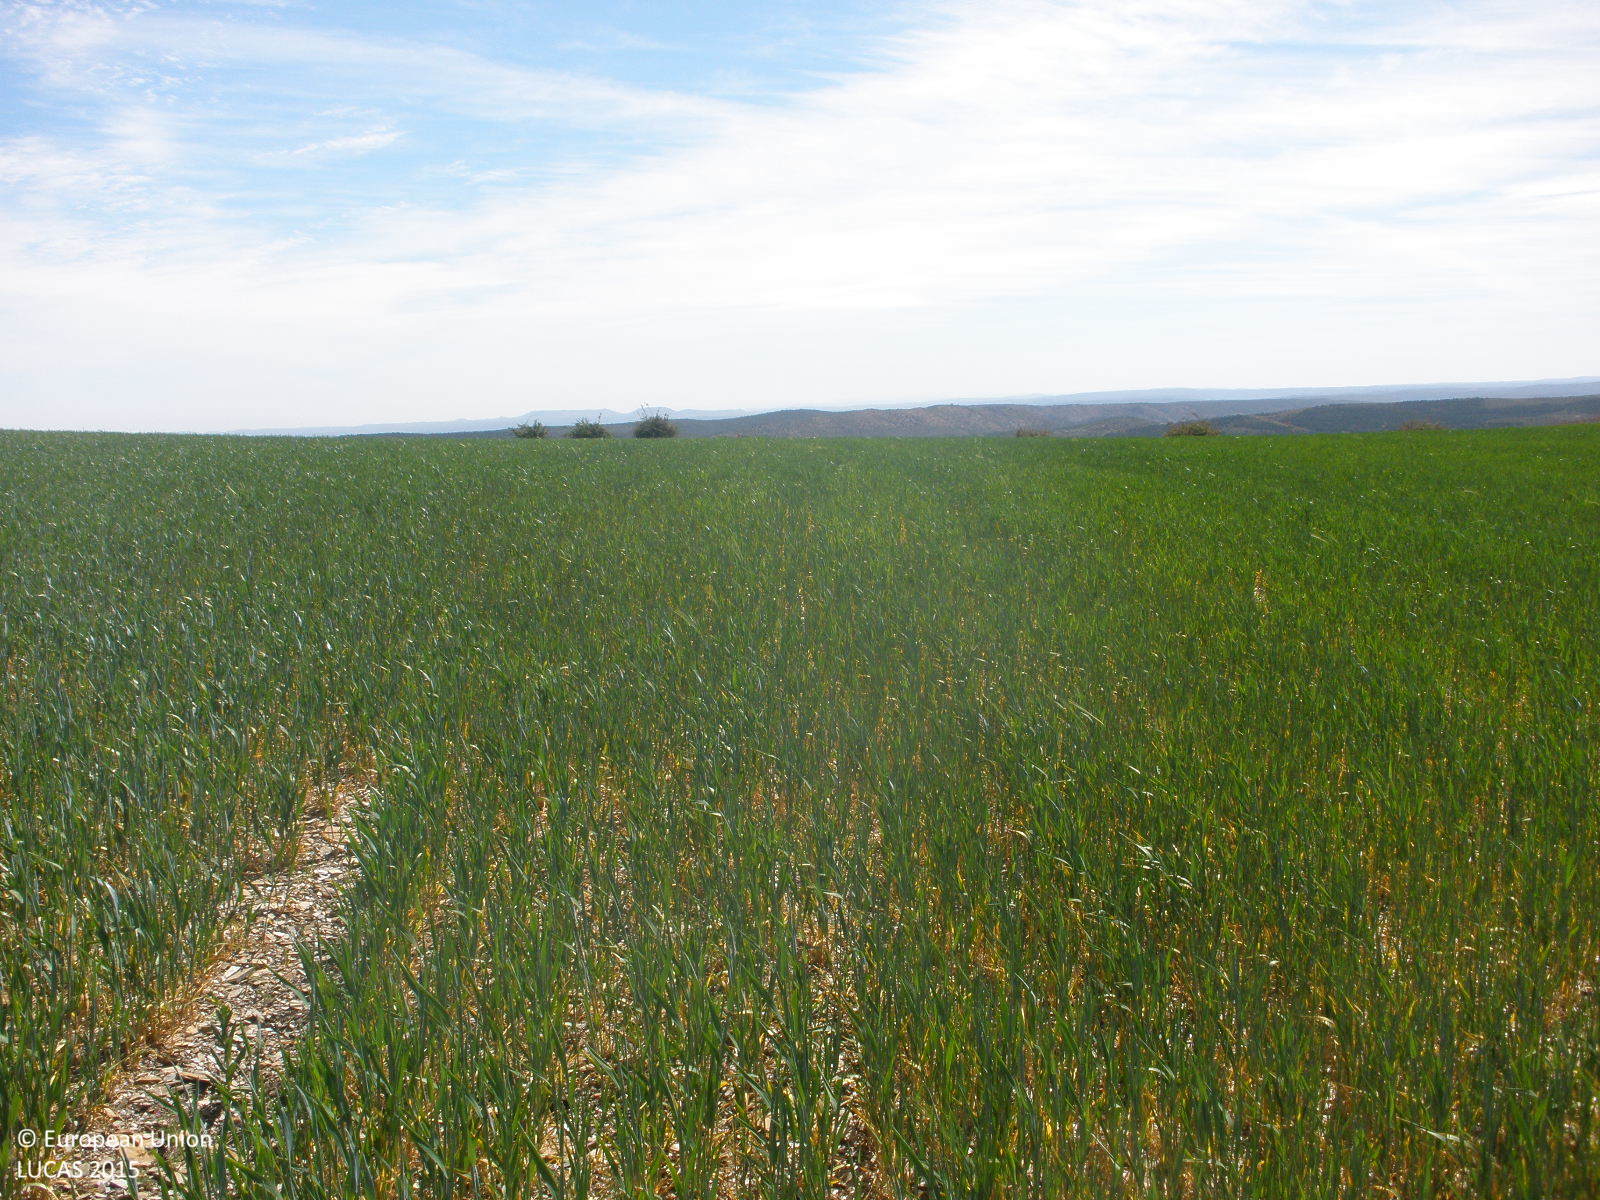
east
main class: Cropland
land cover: Rye
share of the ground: > 75 %
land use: Agriculture (excluding fallow land and kitchen gardens)
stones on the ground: > 50 %
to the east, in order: Rye; Shrubland without tree cover; Tracks; Shrubland without tree cover; Tracks; Shrubland without tree cover; Tracks
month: May
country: ES
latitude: 40.9033
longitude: -0.8529
